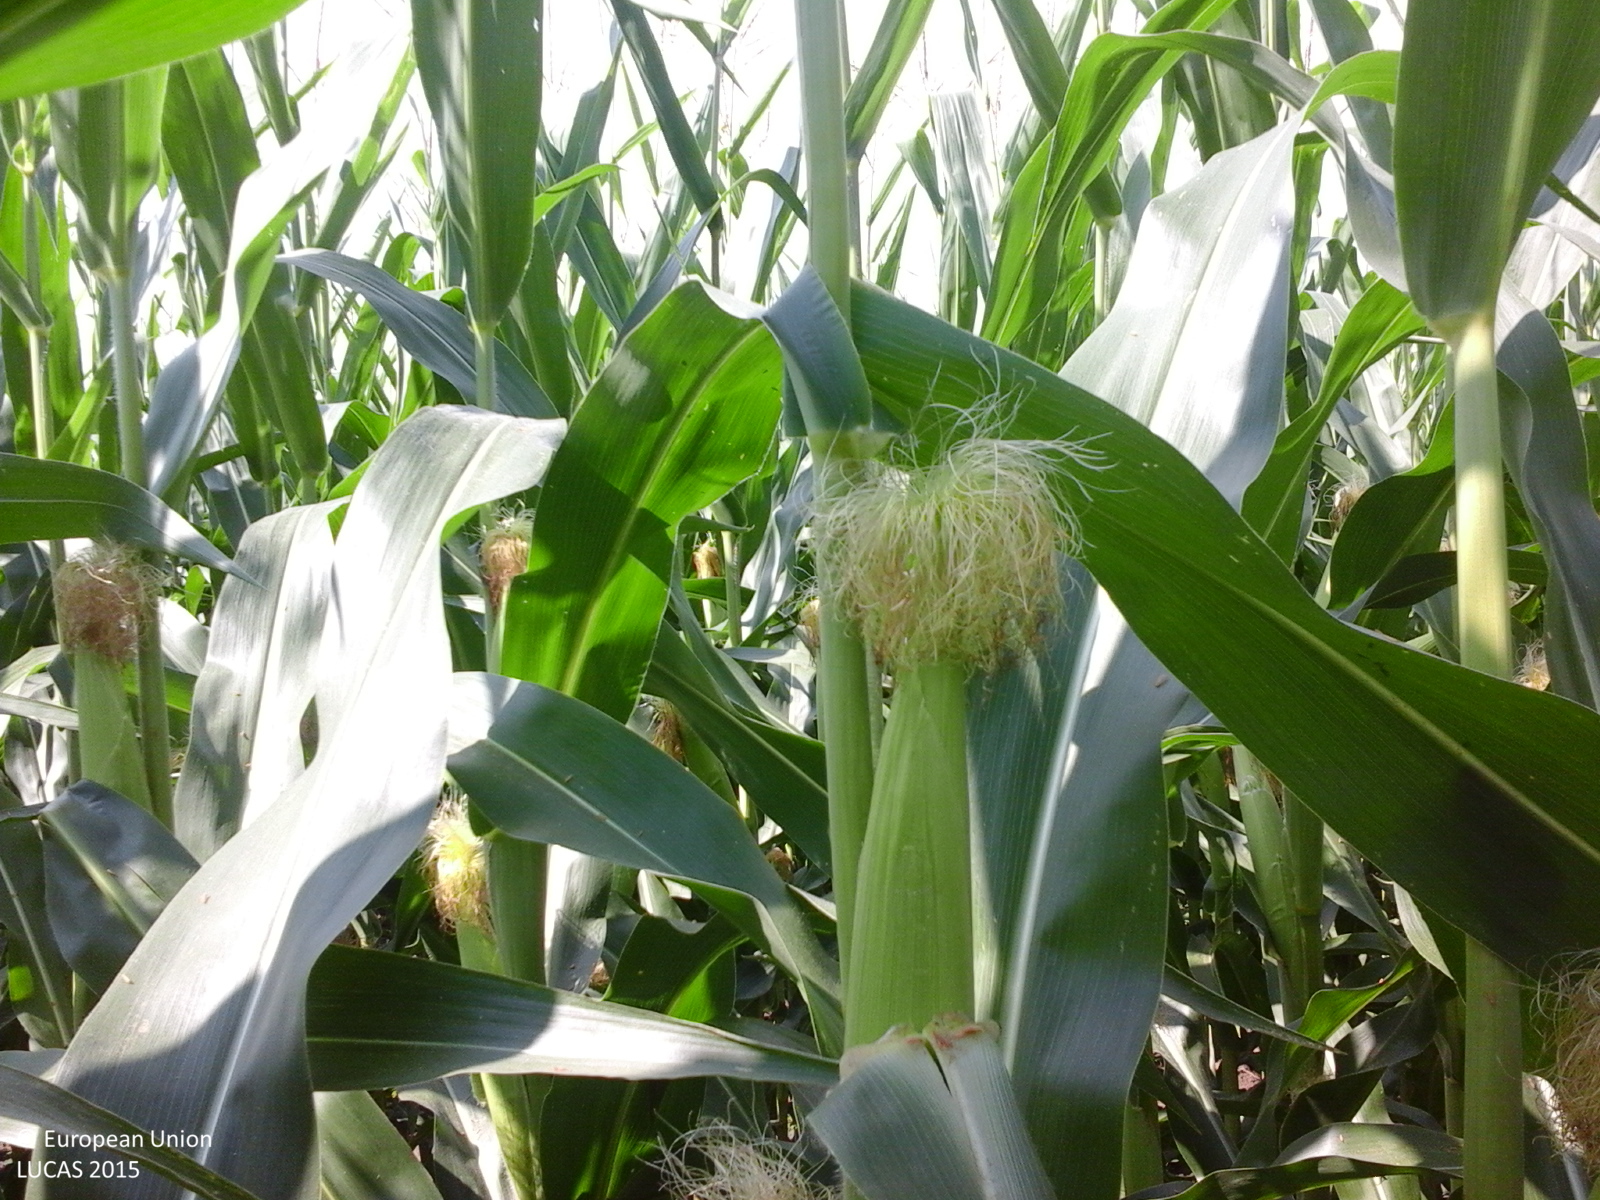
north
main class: Cropland
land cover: Maize
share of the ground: > 75 %
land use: Agriculture (excluding fallow land and kitchen gardens)
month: July
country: RO
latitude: 43.7050
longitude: 25.4076
